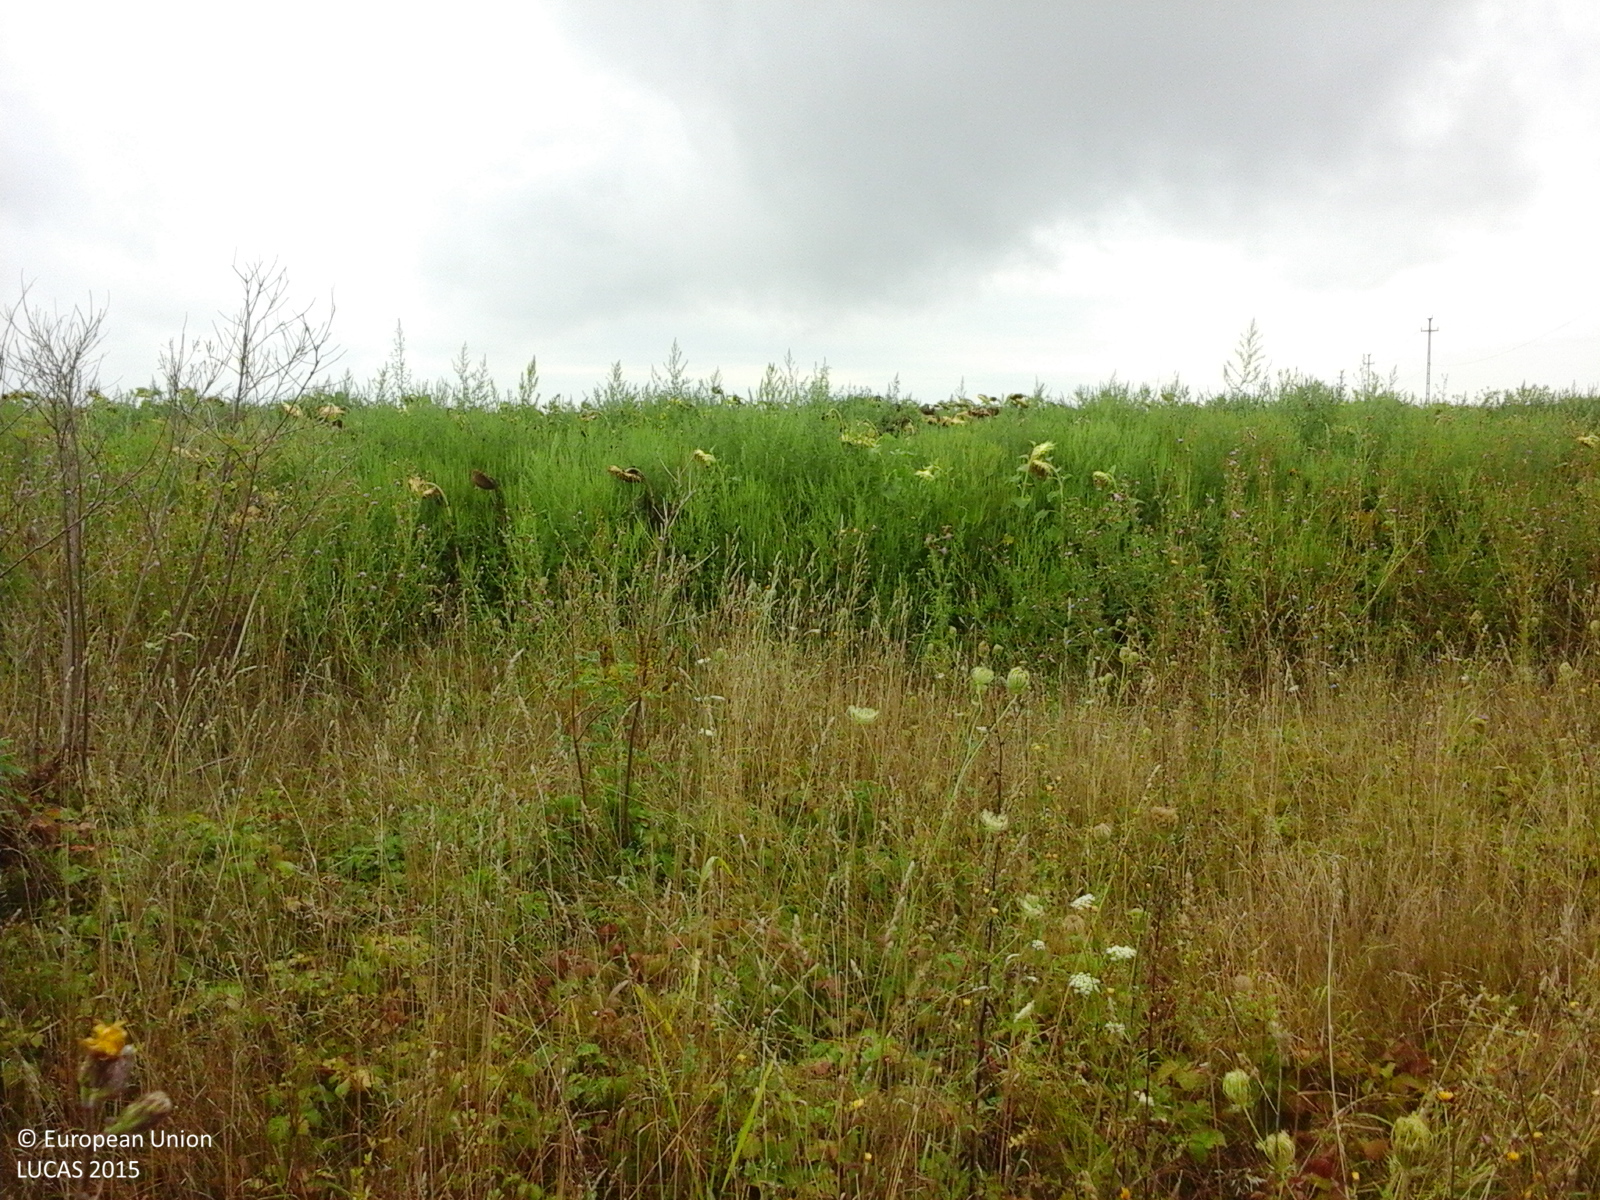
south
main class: Grassland
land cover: Grassland with sparse tree/shrub cover
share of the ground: > 75 %
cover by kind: herbaceous plants 90 %, broadleaved forest trees 5 %, shrubs 5 %
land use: Agriculture (excluding fallow land and kitchen gardens)
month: August
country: RO
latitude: 45.7753
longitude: 20.7122
